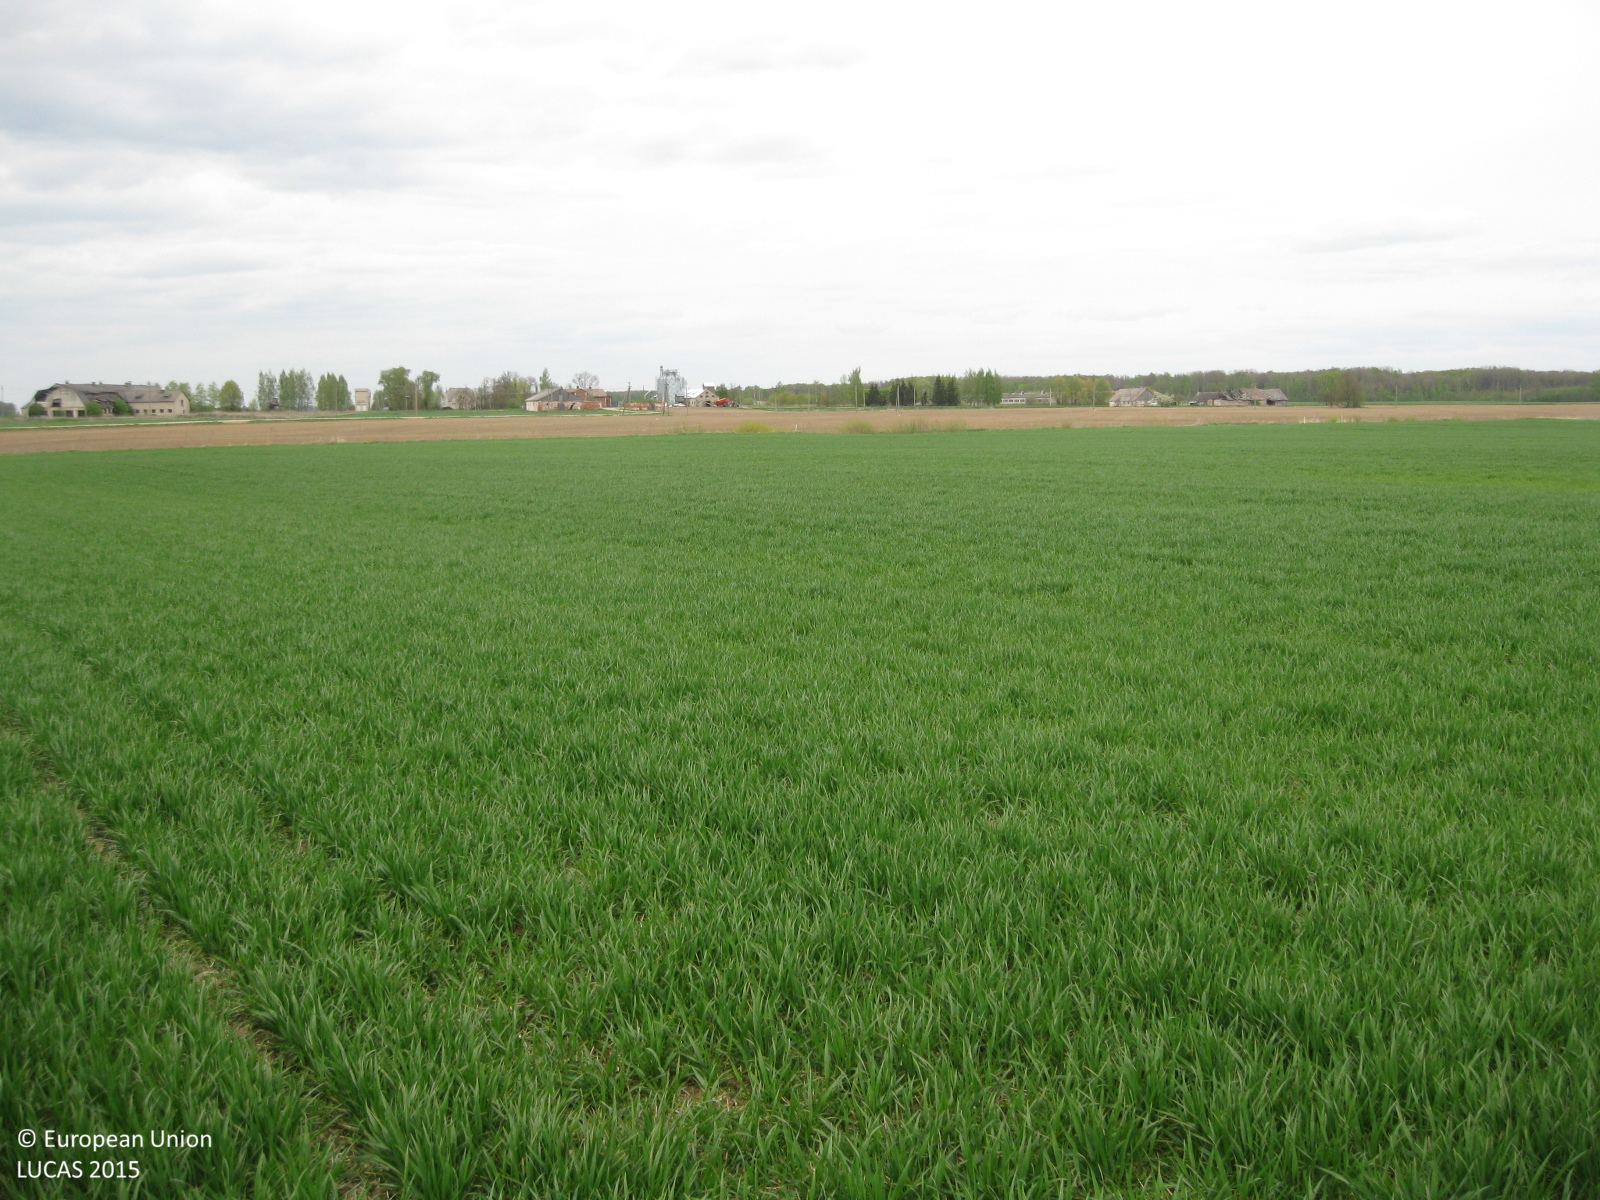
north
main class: Cropland
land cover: Common wheat
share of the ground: > 75 %
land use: Agriculture (excluding fallow land and kitchen gardens)
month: May
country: LT
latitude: 56.1870
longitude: 24.4527
